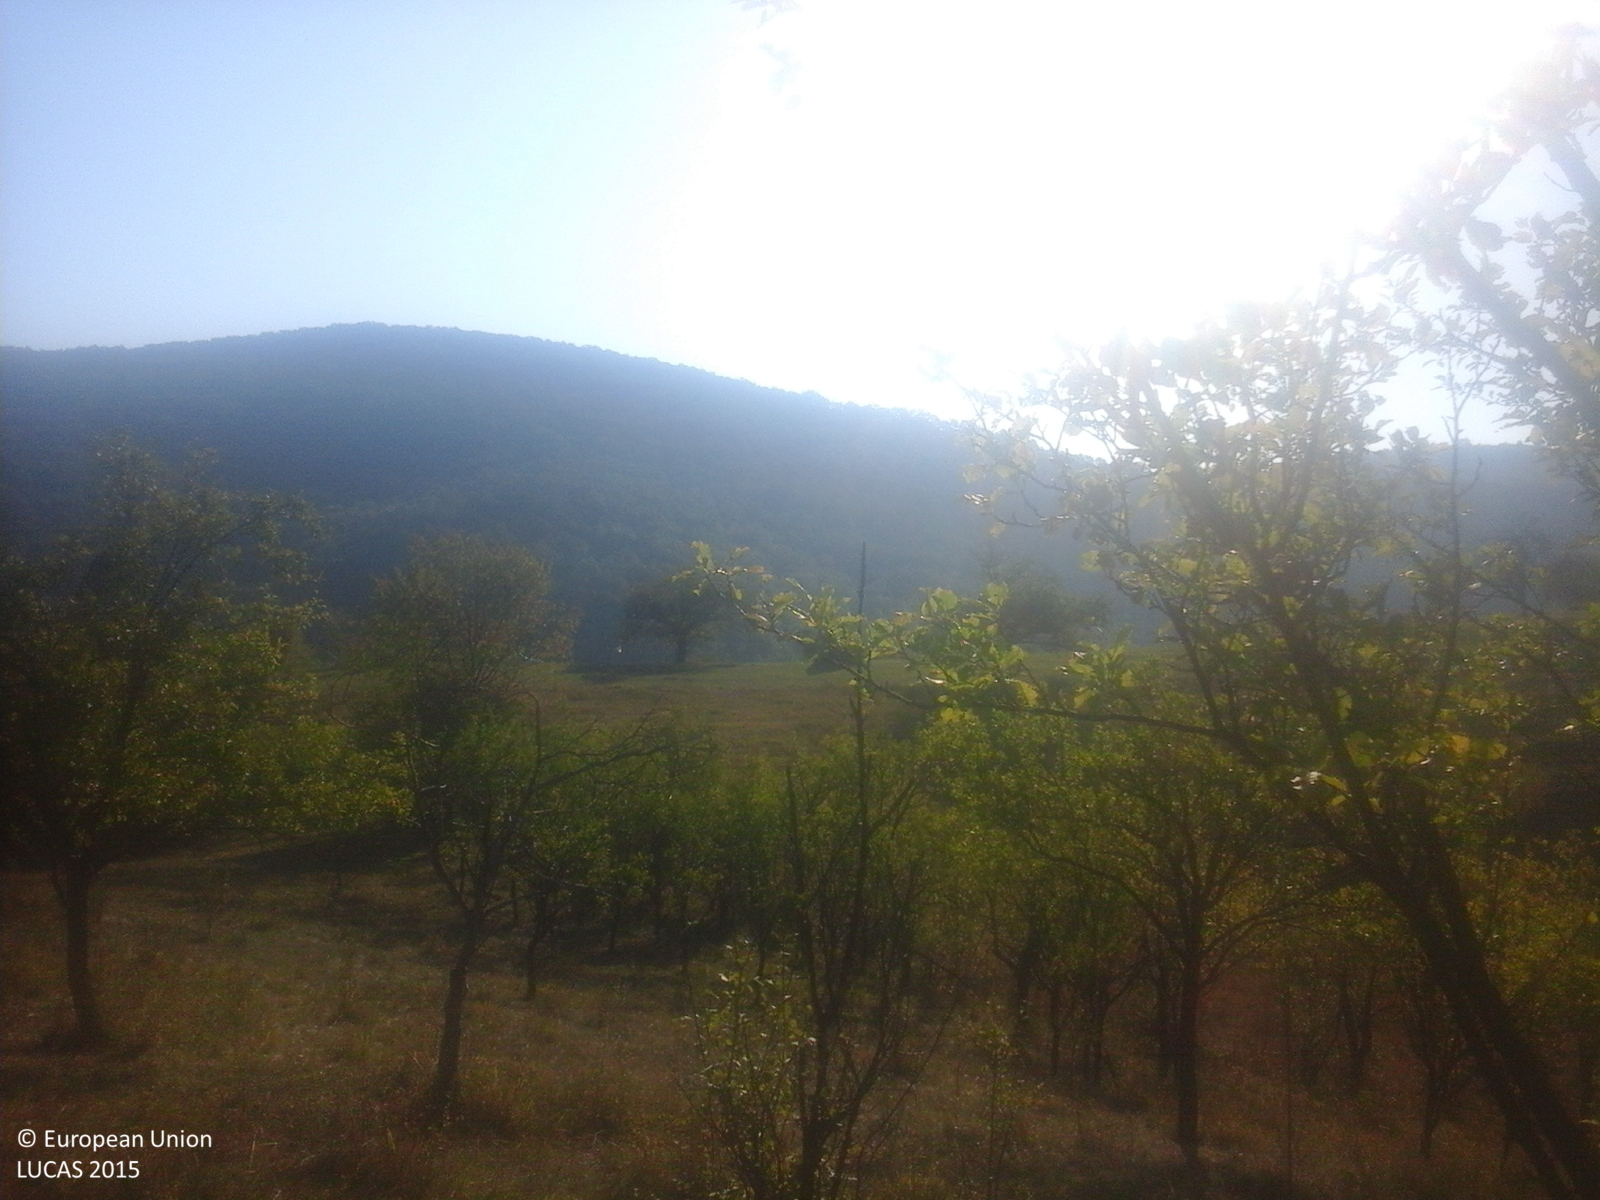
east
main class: Cropland
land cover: Apple fruit
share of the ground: > 75 %
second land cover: Grassland without tree/shrub cover
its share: > 75 %
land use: Agriculture (excluding fallow land and kitchen gardens)
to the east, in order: Apple fruit; Grassland without tree/shrub cover; Fences; Grassland with sparse tree/shrub cover; Grassland without tree/shrub cover; Tracks; Grassland with sparse tree/shrub cover; Broadleaved woodland; Tracks; Broadleaved woodland
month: September
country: RO
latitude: 46.6527
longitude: 22.1869
